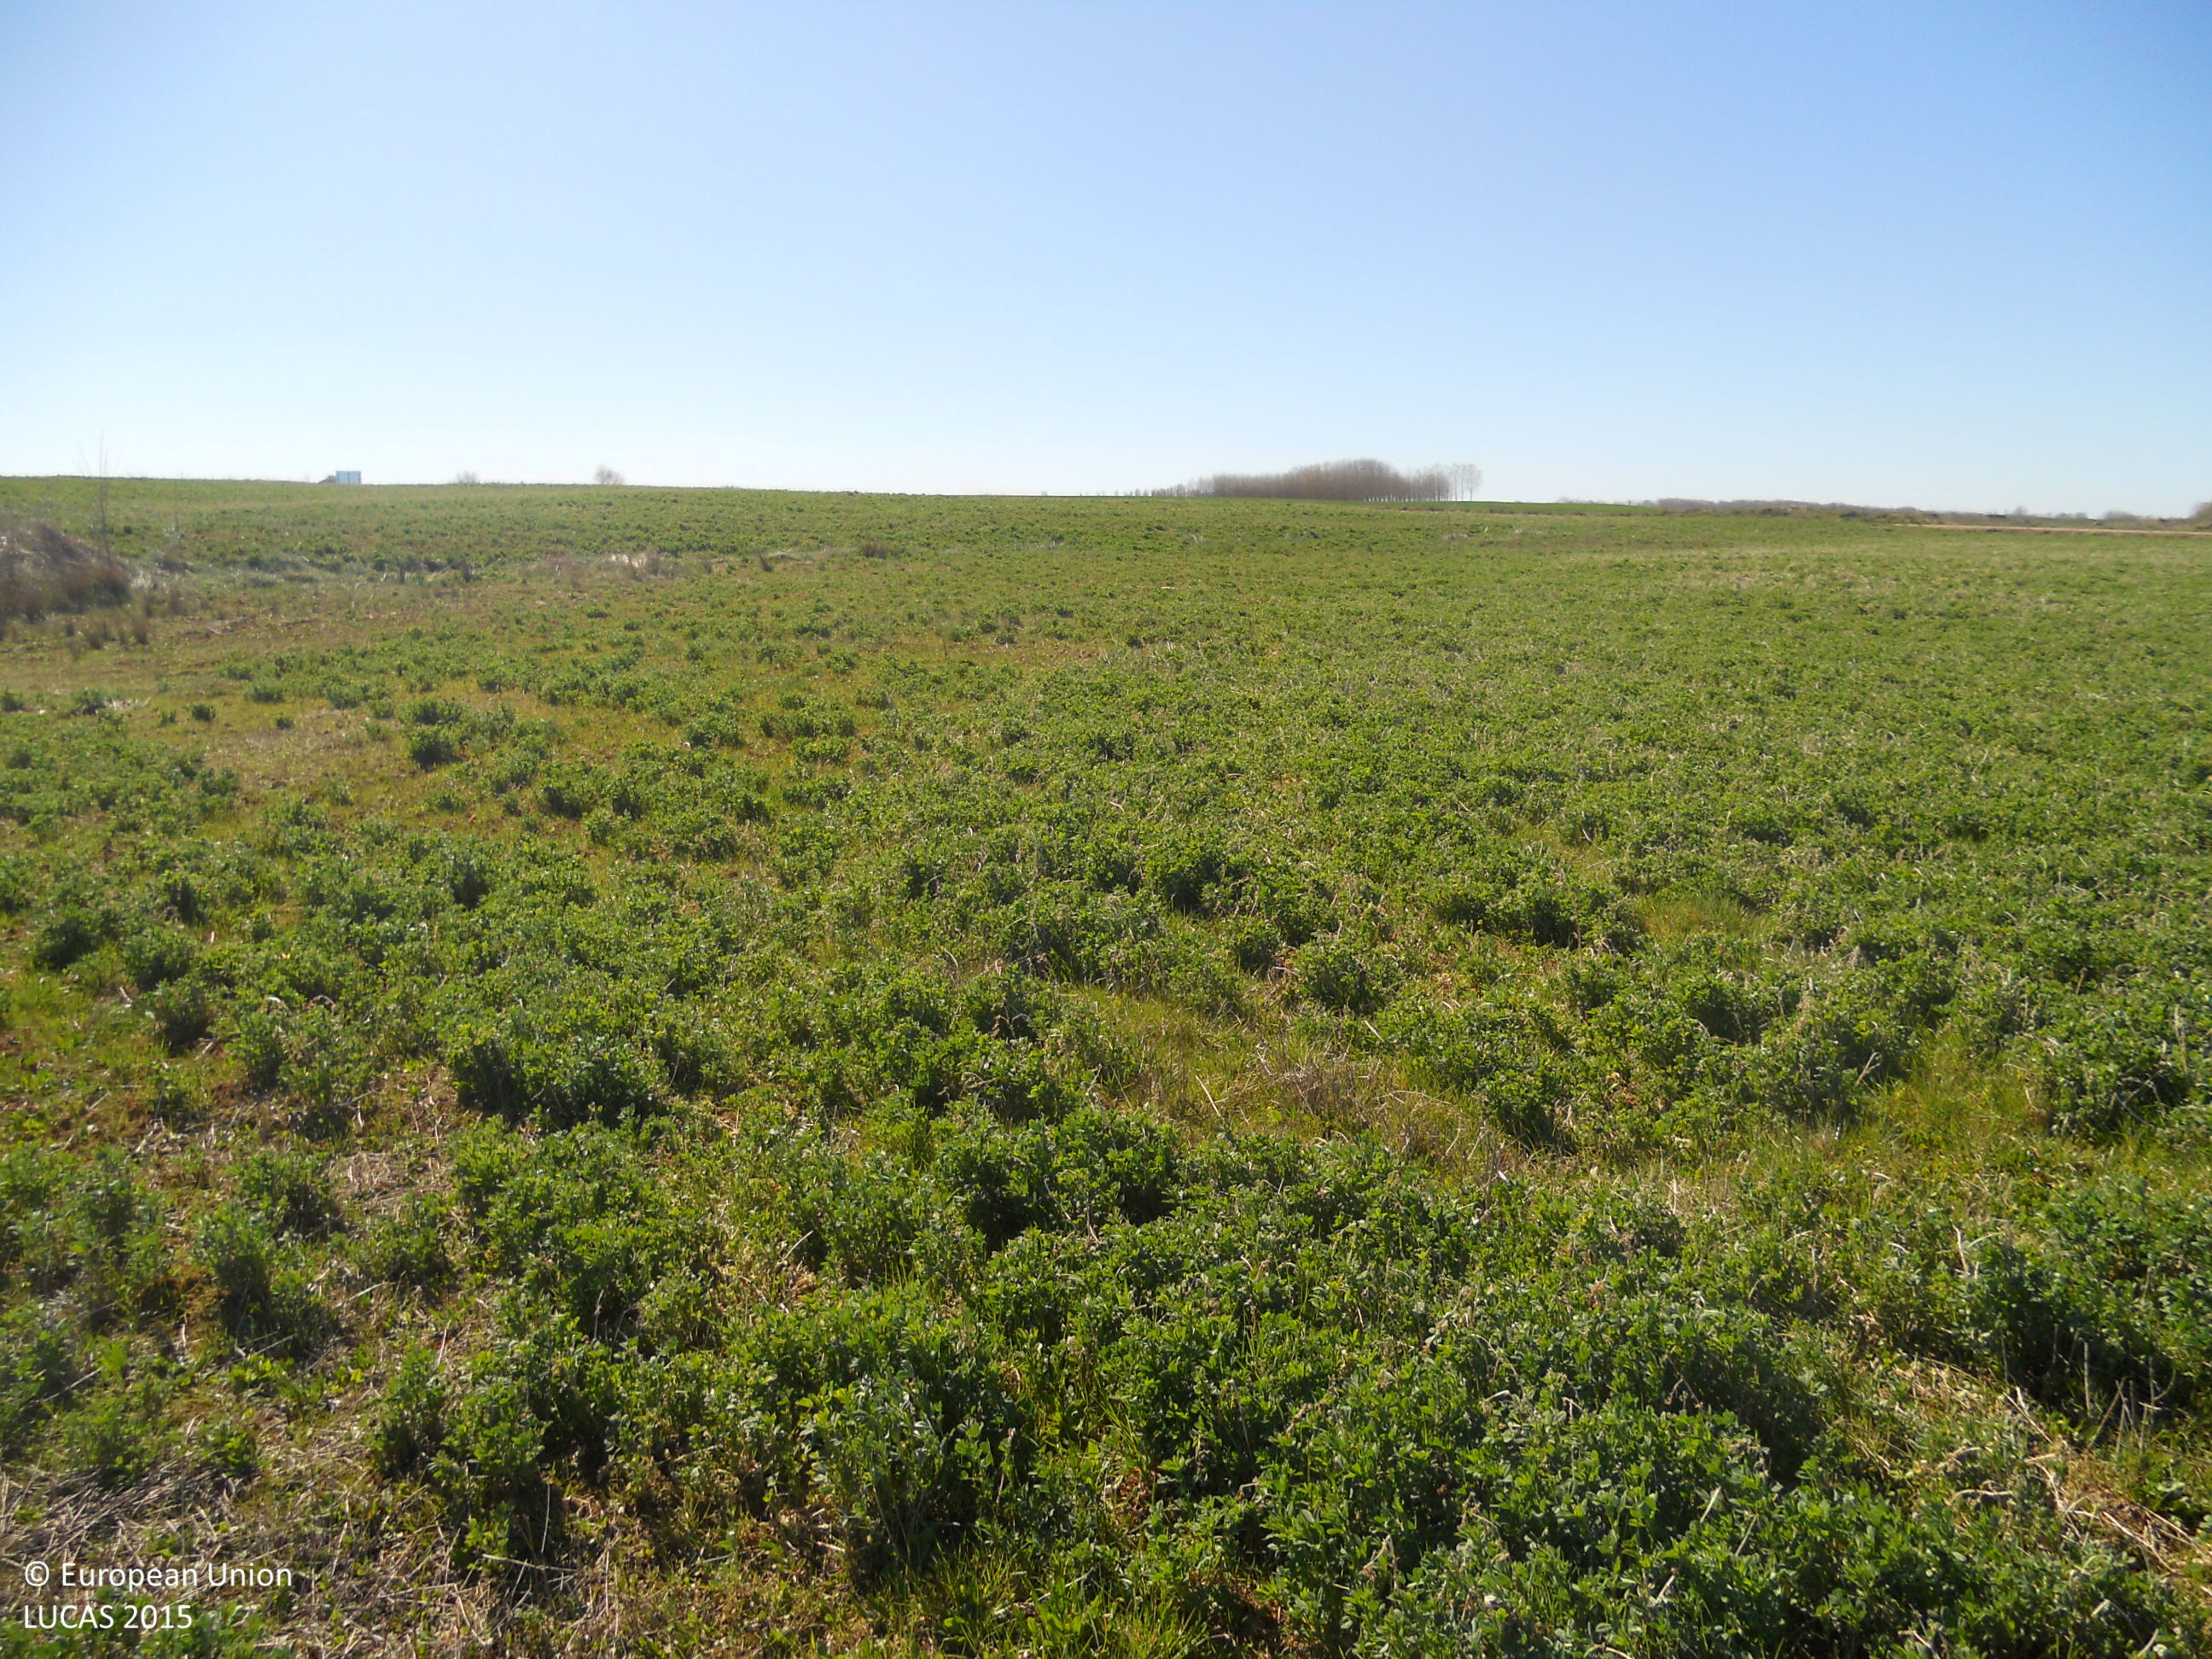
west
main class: Cropland
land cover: Lucerne
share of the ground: 50 - 75 %
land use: Agriculture (excluding fallow land and kitchen gardens)
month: April
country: ES
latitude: 42.3285
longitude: -4.3049
